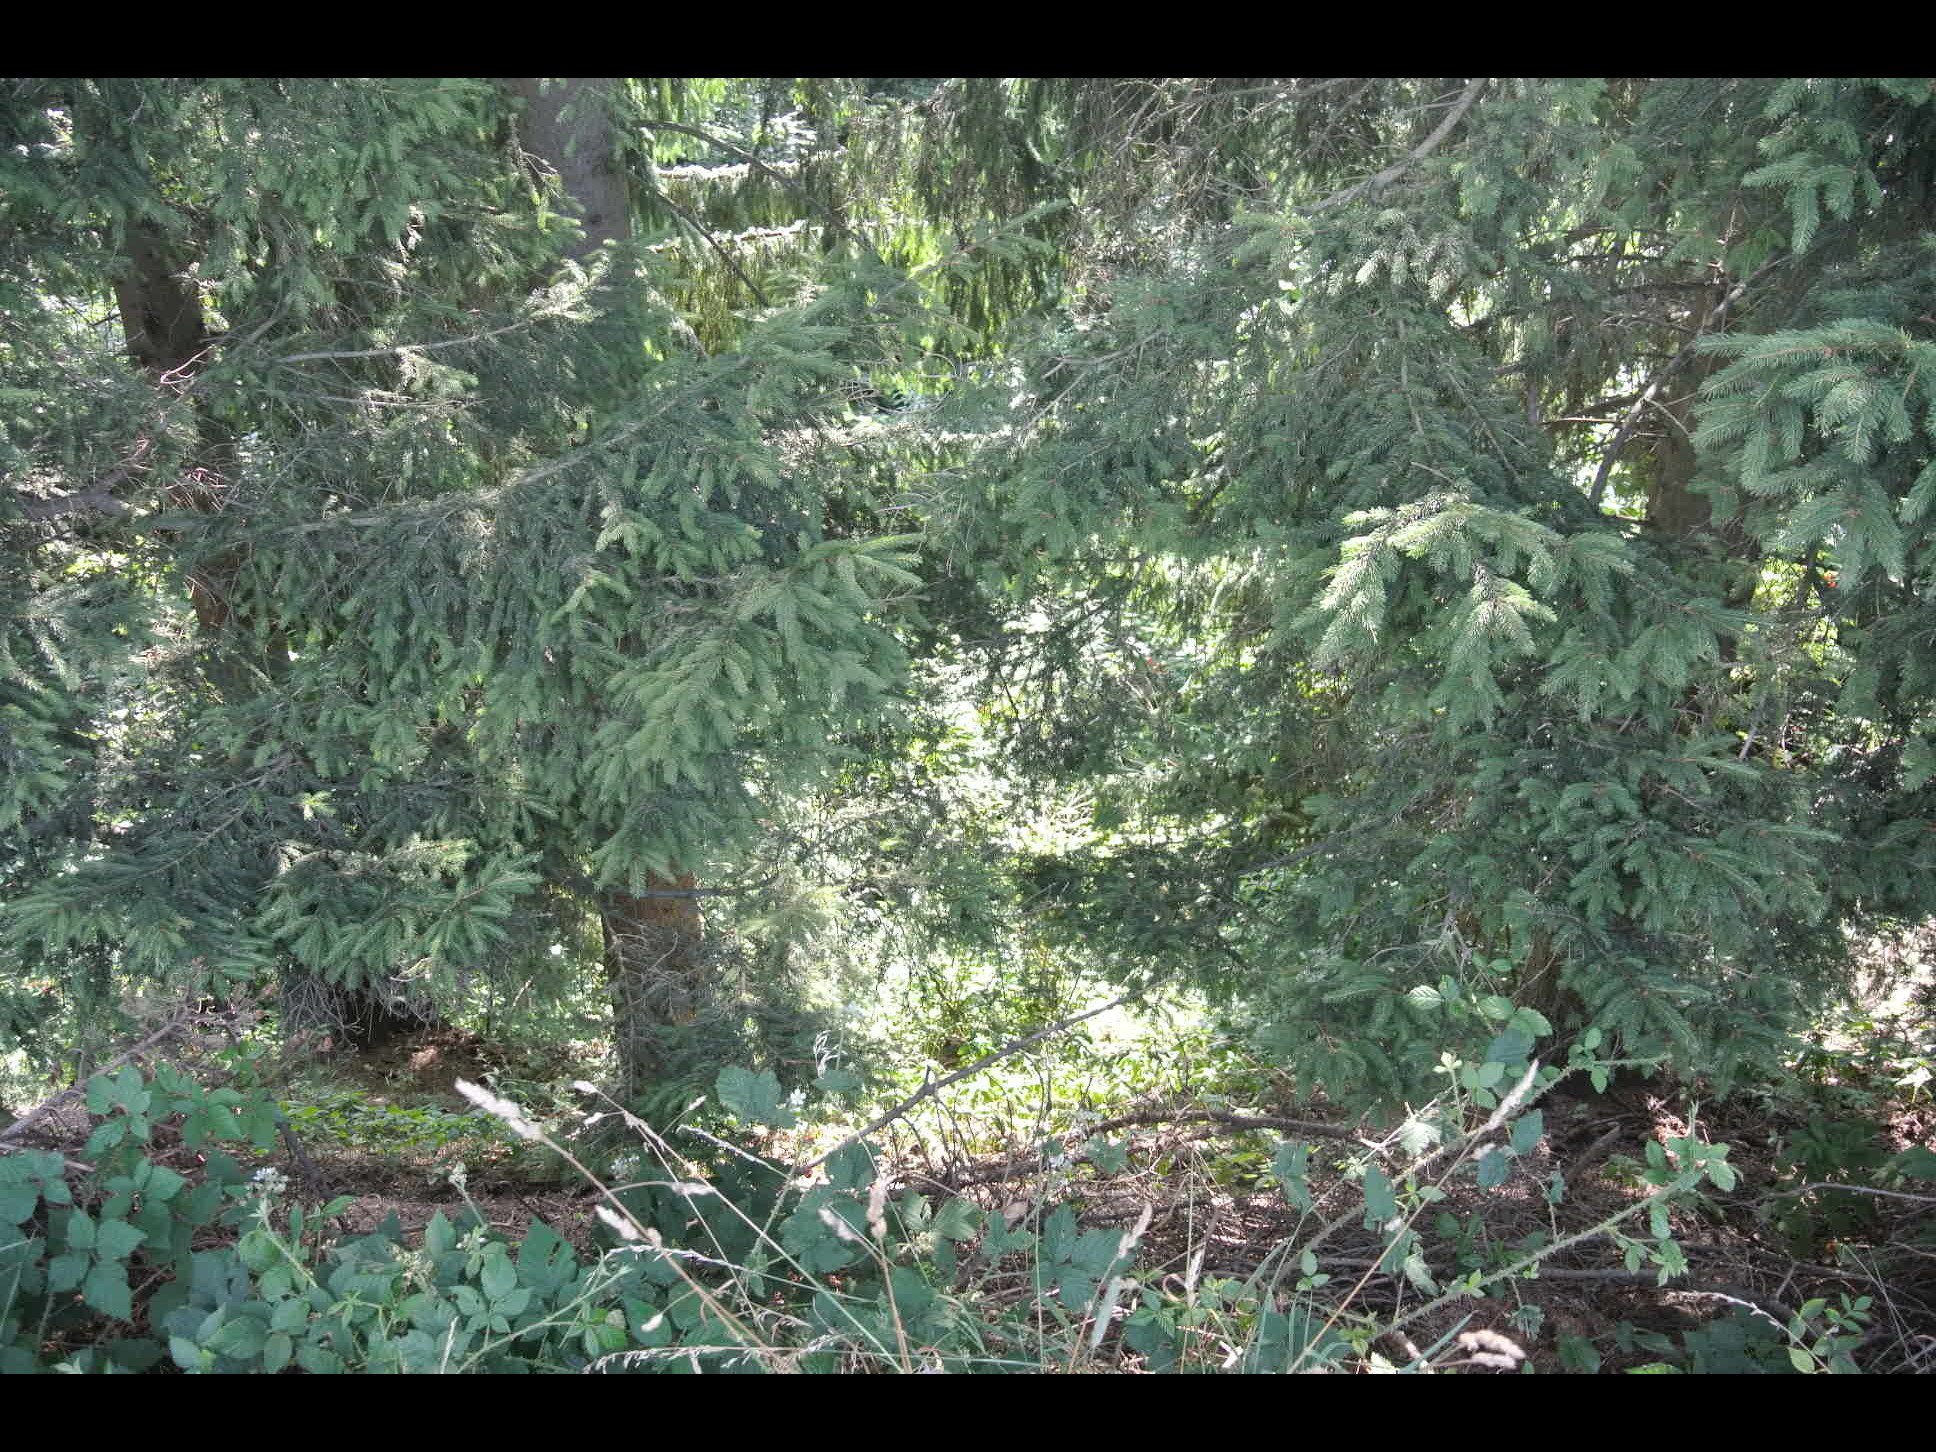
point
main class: Woodland
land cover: Broadleaved woodland
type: floodplain forest
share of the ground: > 75 %
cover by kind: broadleaved forest trees 100 %
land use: Forestry
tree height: > 5 m
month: July
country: AT
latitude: 47.5626
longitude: 16.1832
